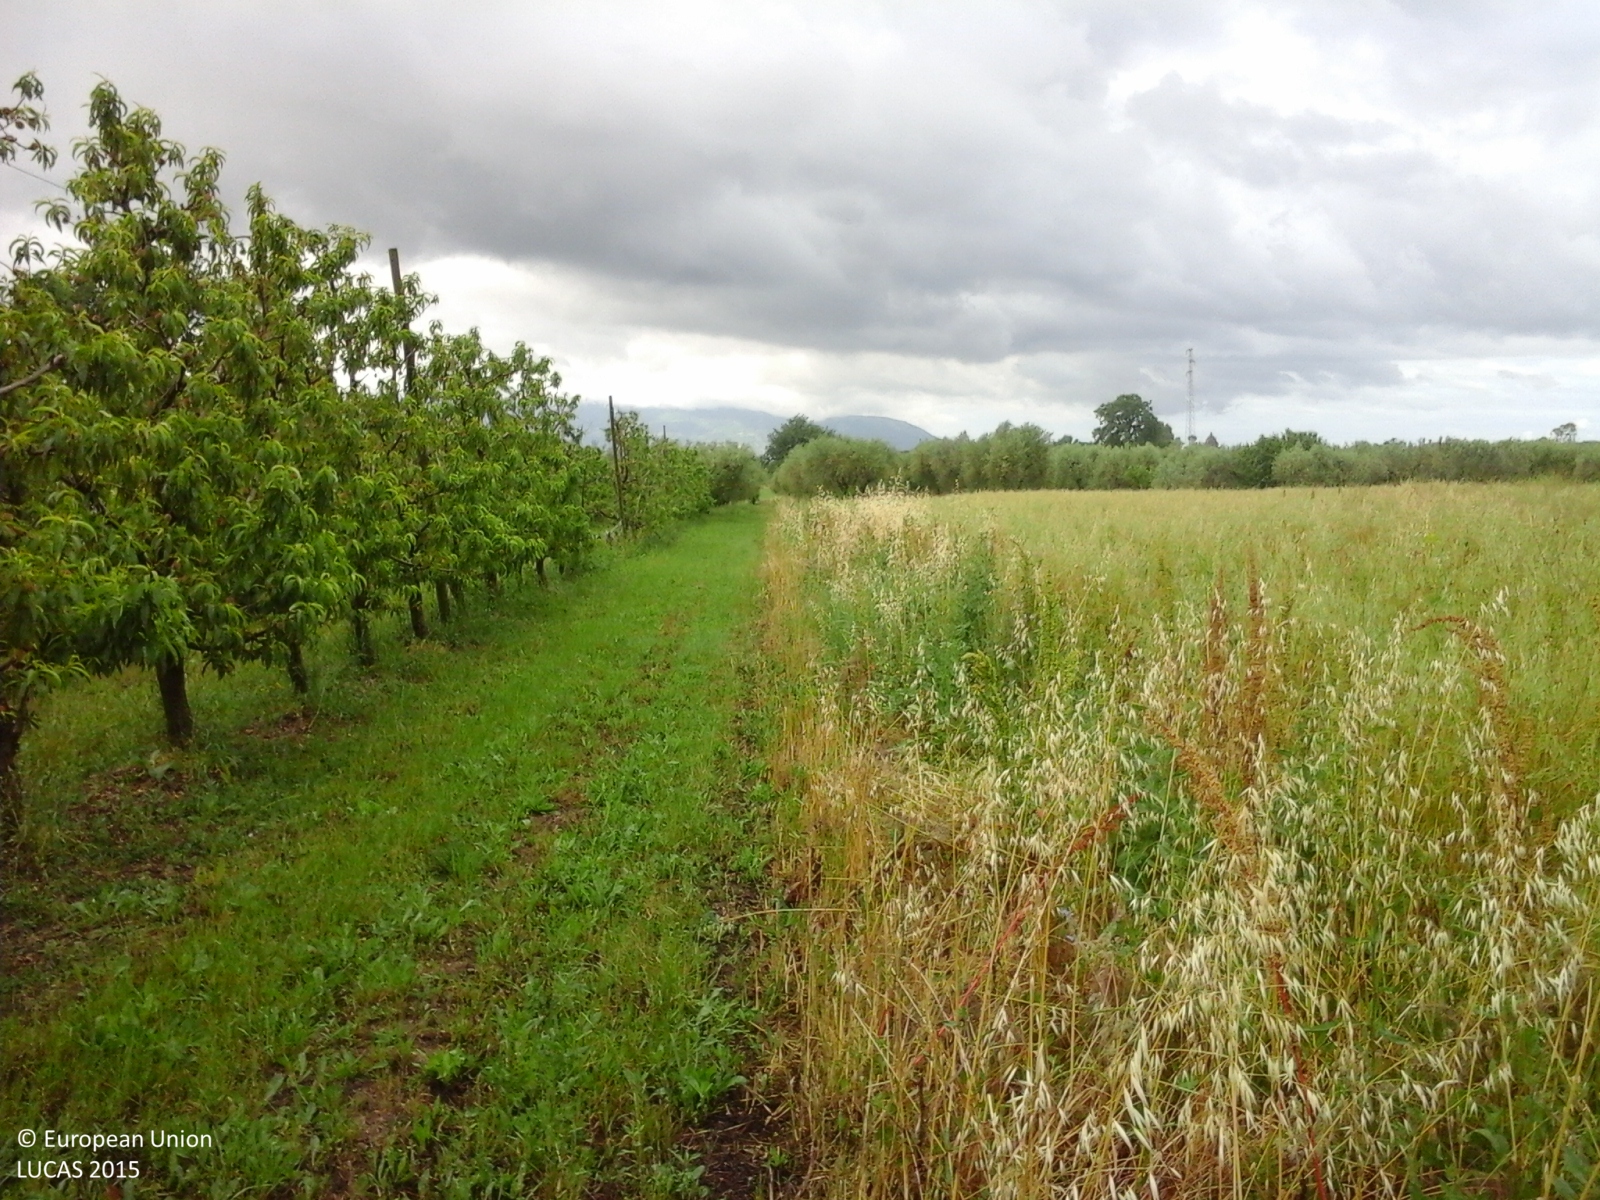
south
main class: Cropland
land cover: Mixed cereals for fodder
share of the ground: > 75 %
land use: Agriculture (excluding fallow land and kitchen gardens)
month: May
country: IT
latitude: 40.5869
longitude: 15.1183
